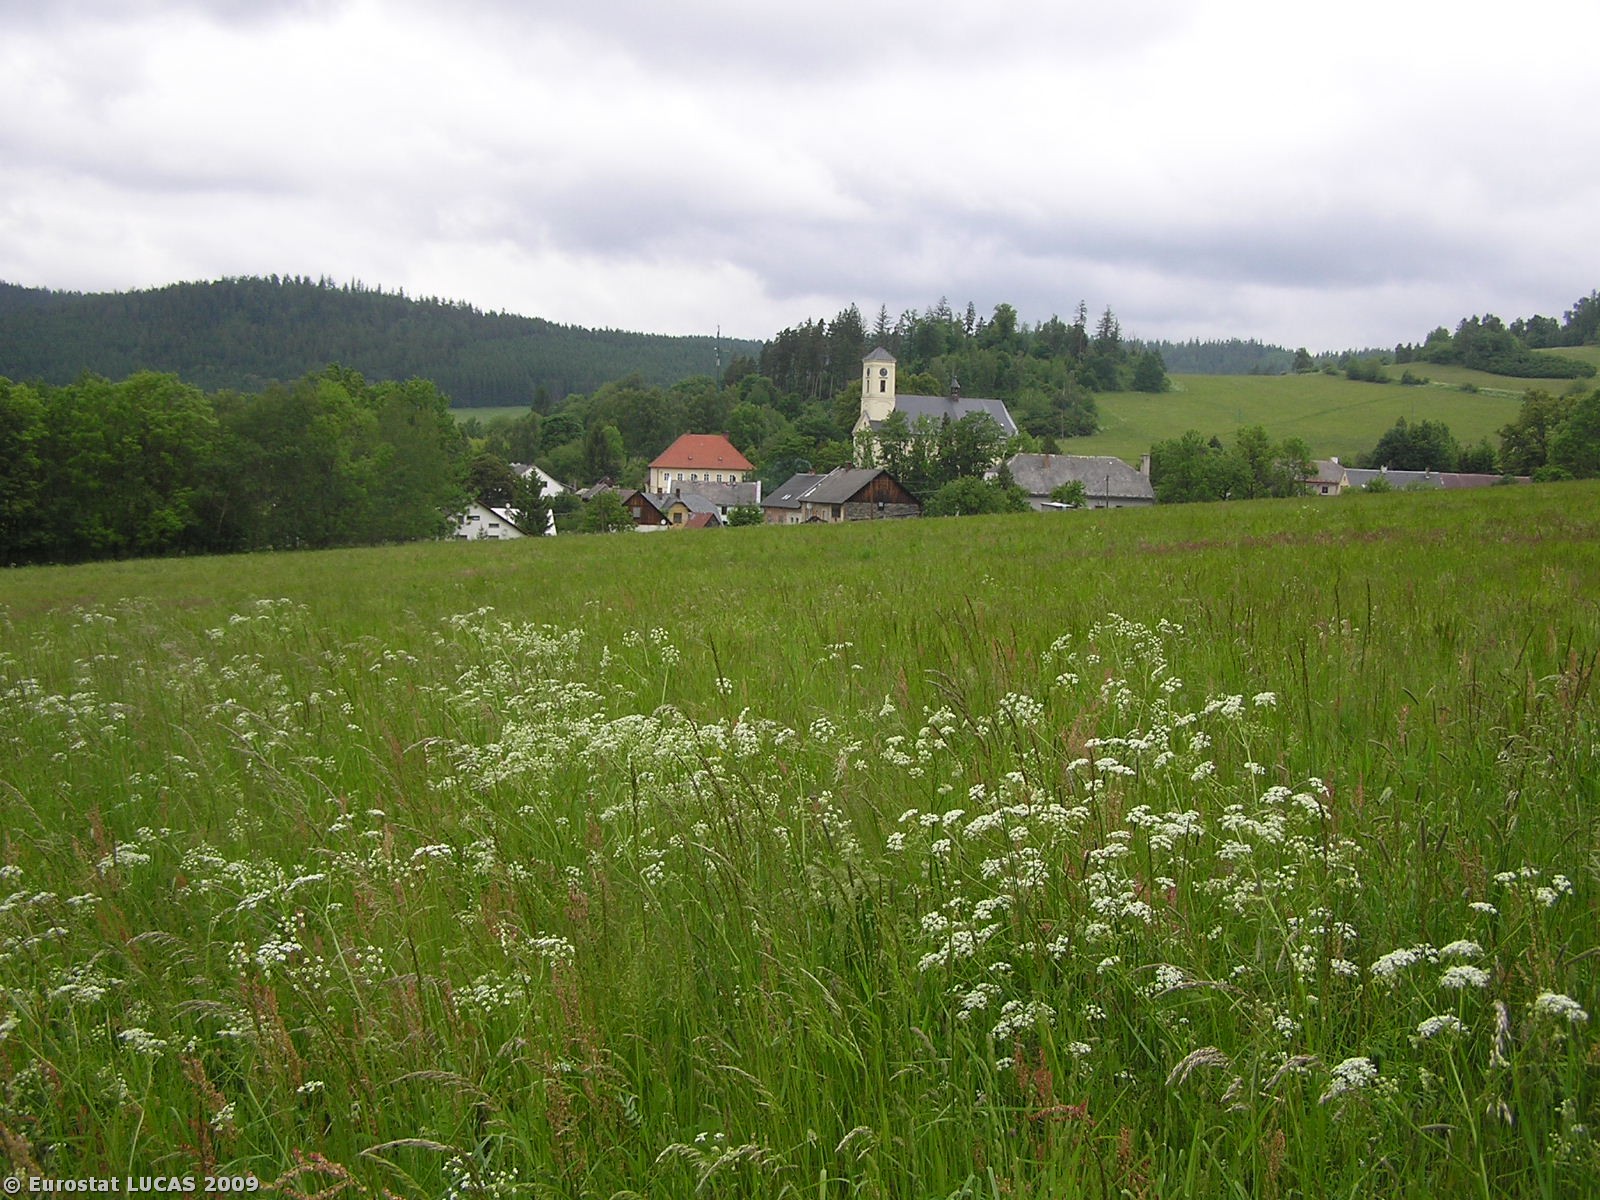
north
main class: Grassland
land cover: Grassland without tree/shrub cover
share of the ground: > 75 %
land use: Agriculture (excluding fallow land and kitchen gardens)
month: June
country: CZ
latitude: 50.0644
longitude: 17.4862
